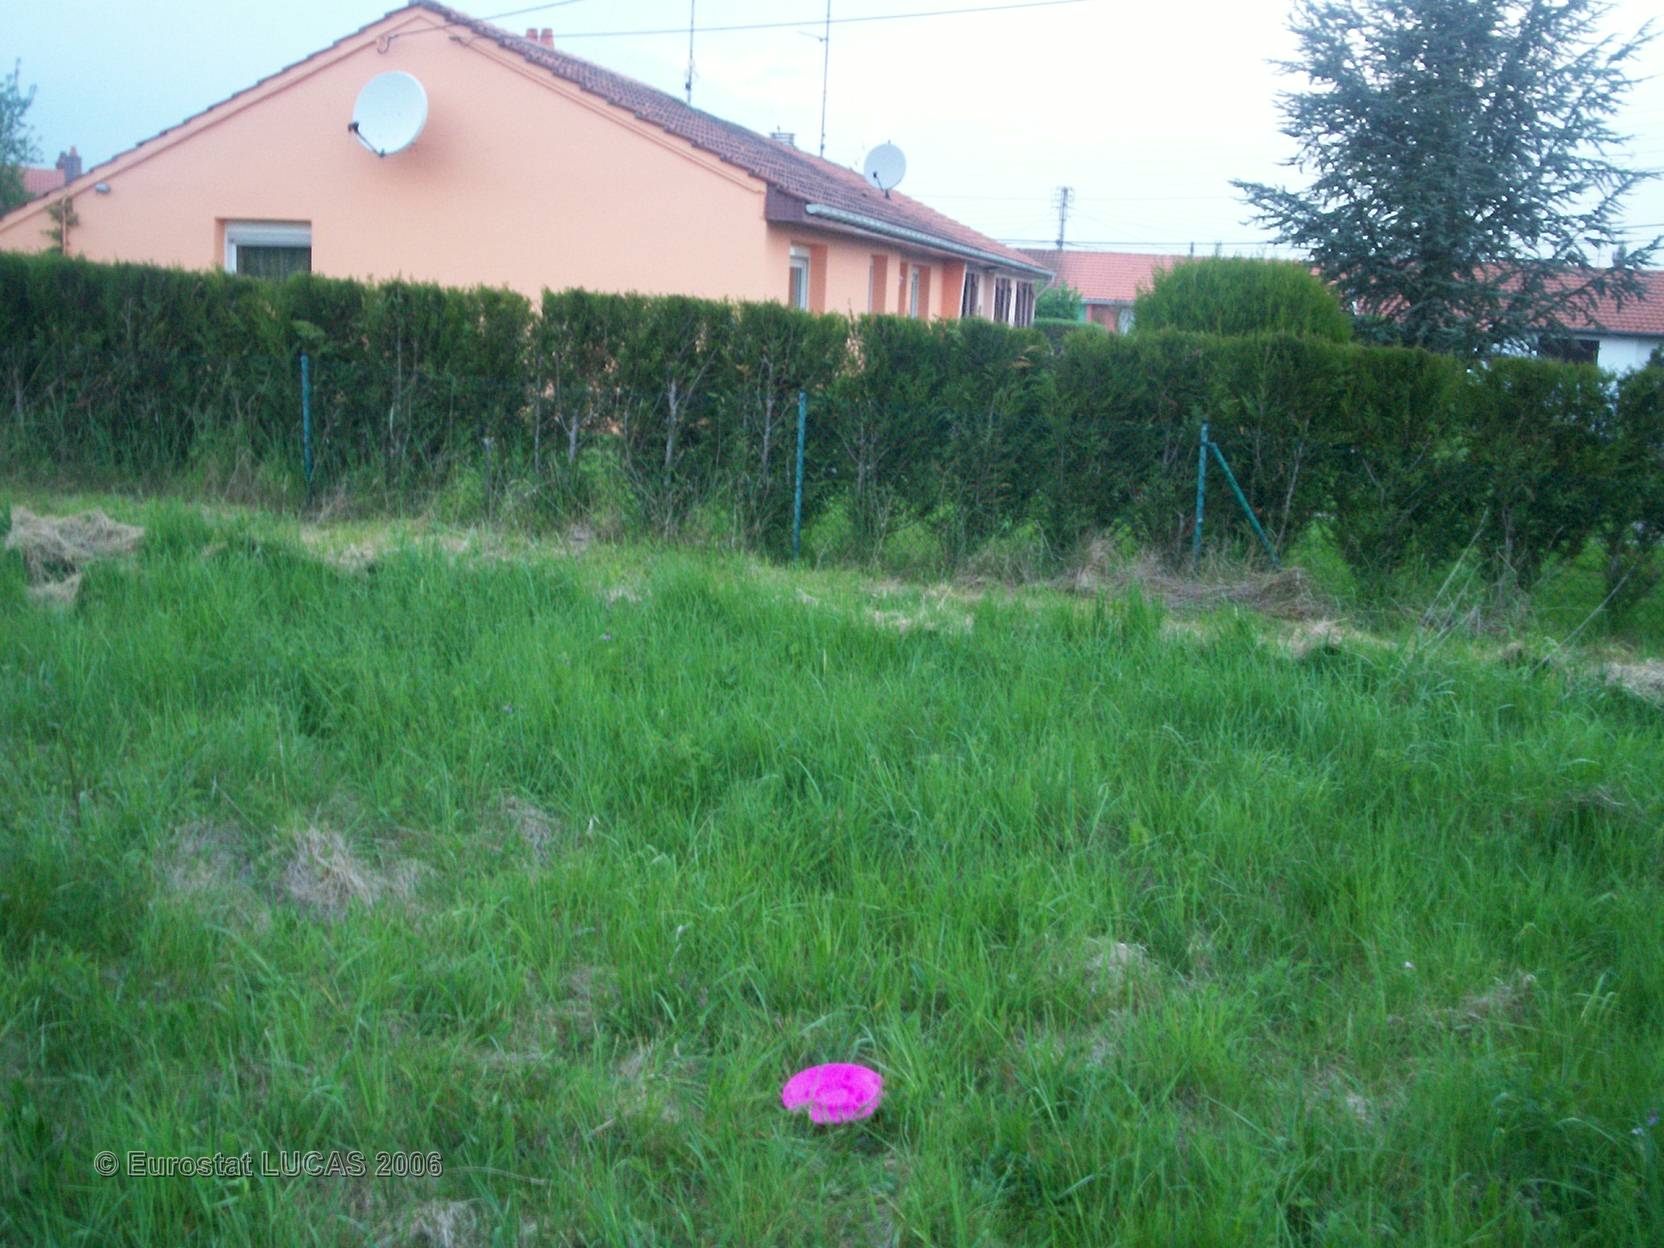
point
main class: Grassland
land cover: Grassland without tree/shrub cover
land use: Agriculture (excluding fallow land and kitchen gardens)
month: May
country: FR
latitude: 48.7430
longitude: 7.0768
